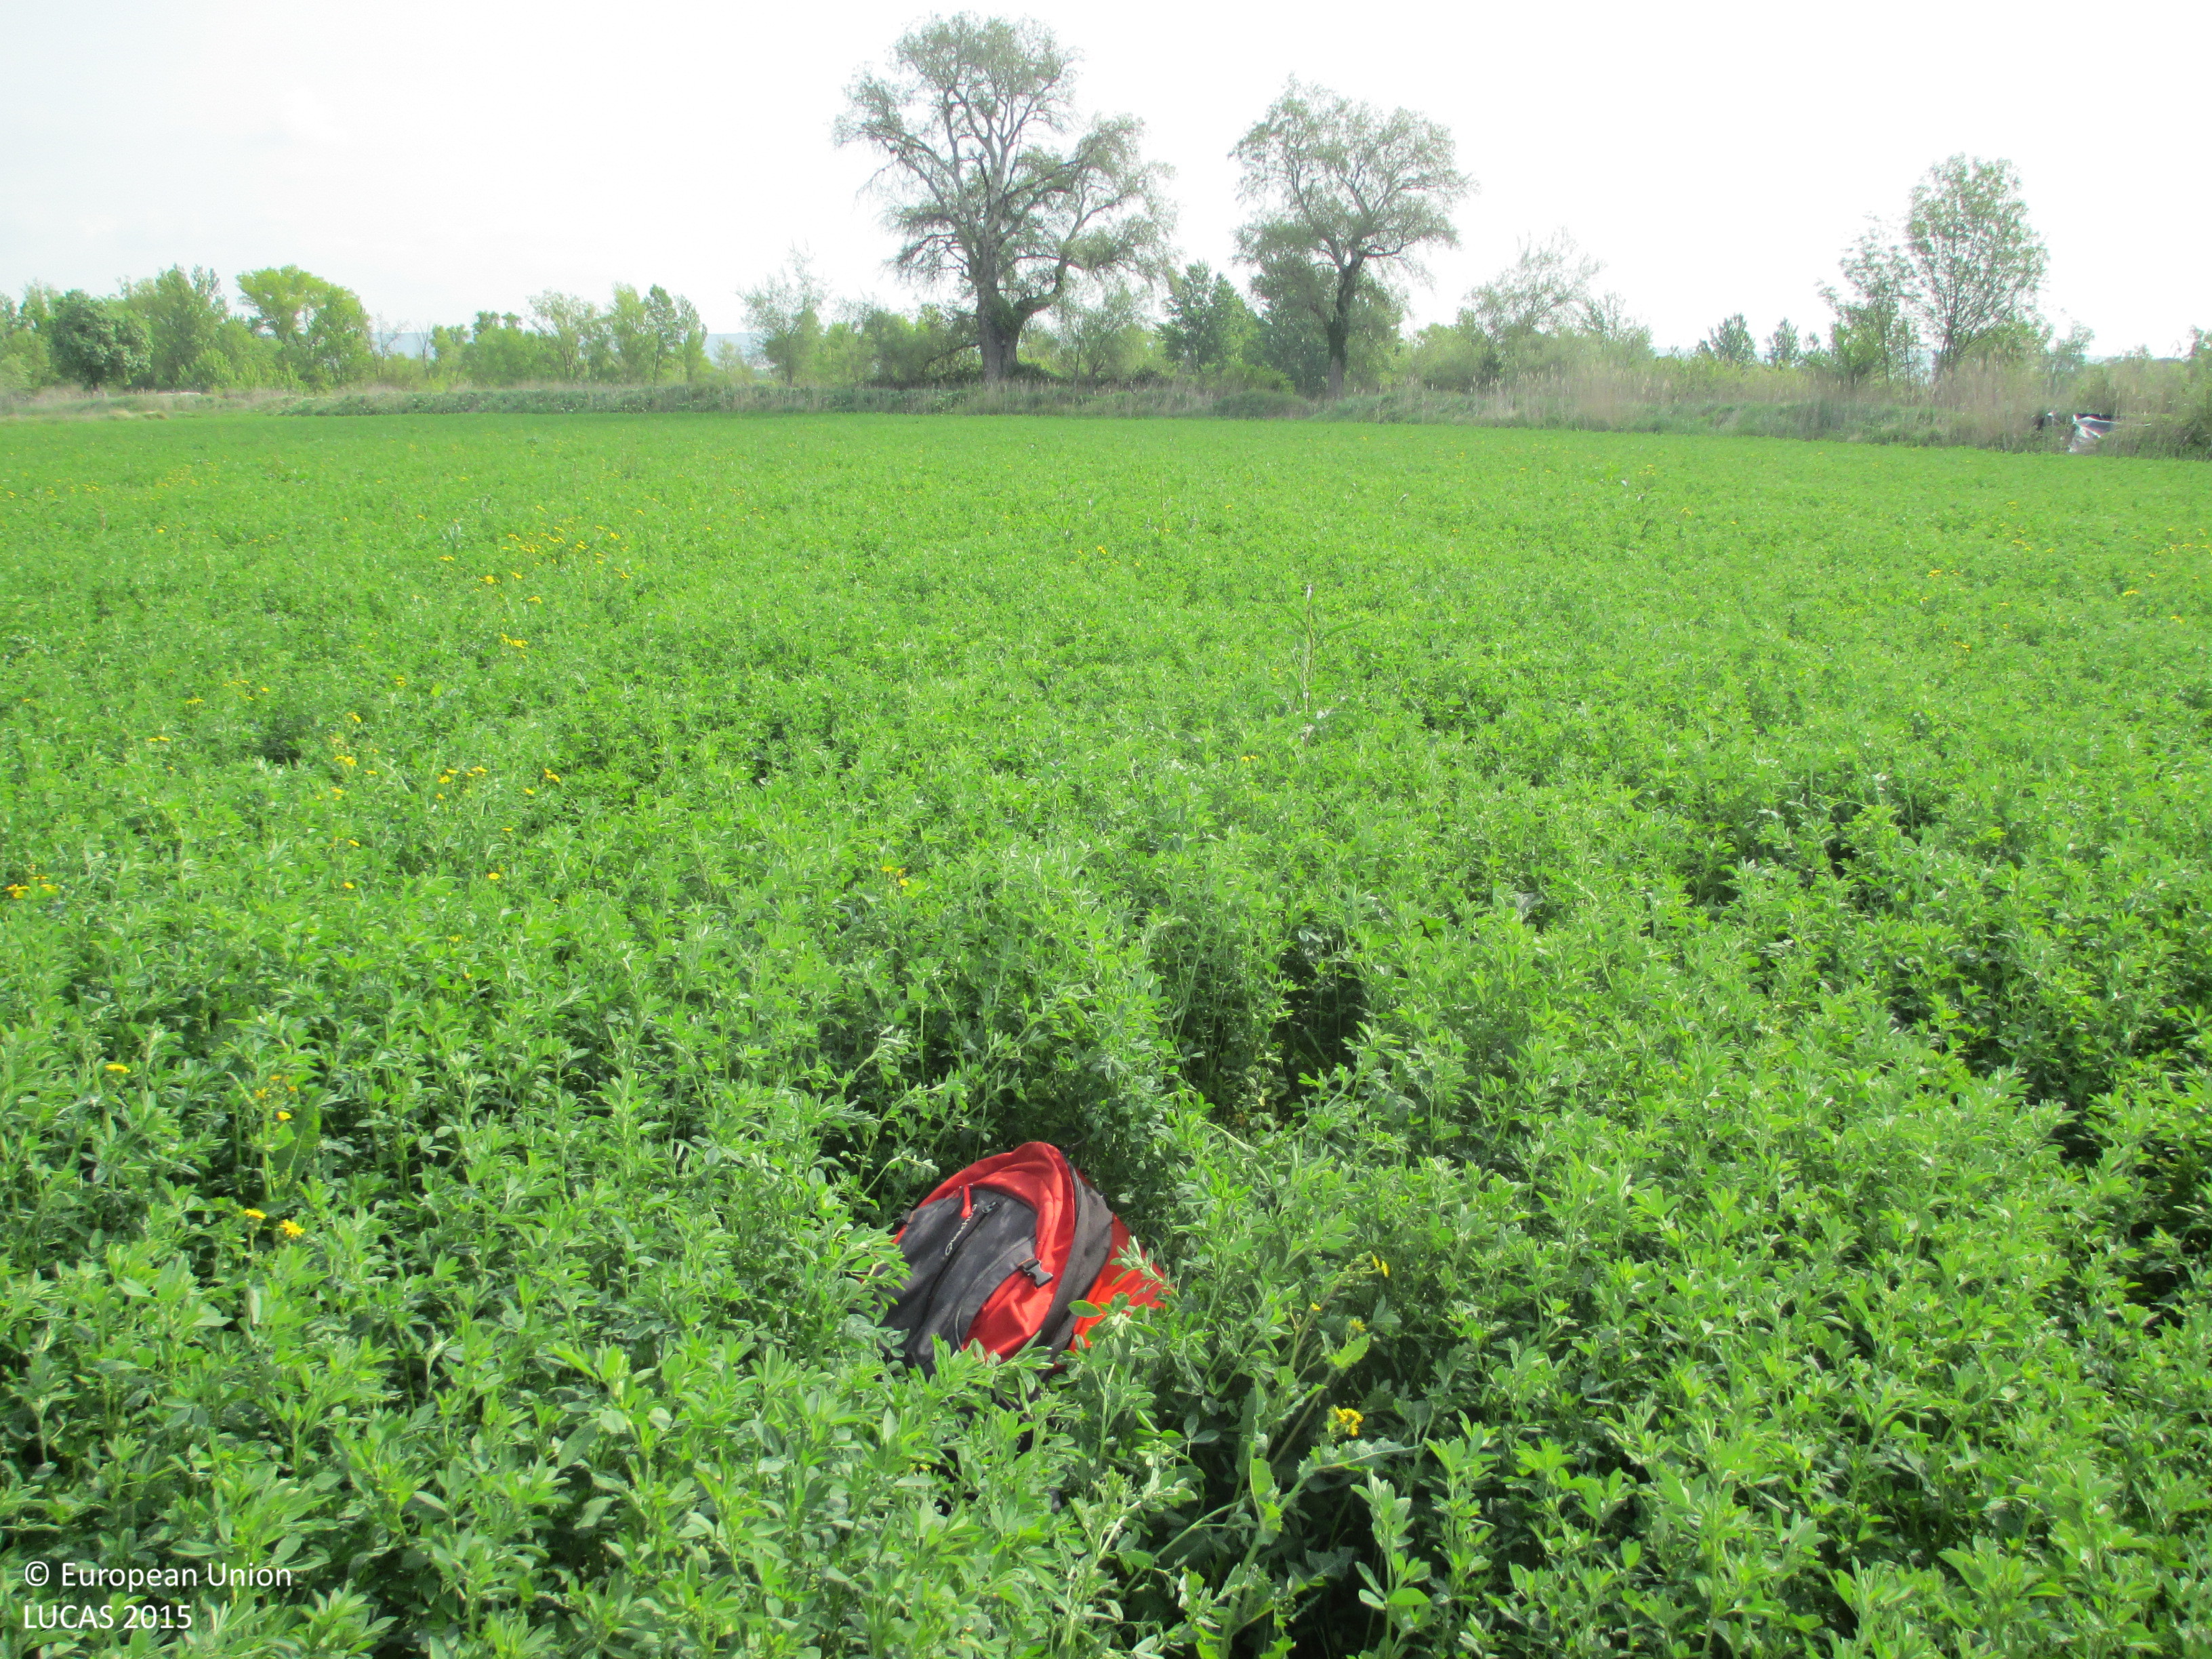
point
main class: Cropland
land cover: Lucerne
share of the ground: > 75 %
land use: Agriculture (excluding fallow land and kitchen gardens)
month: April
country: ES
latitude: 42.0827
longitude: -0.3817
